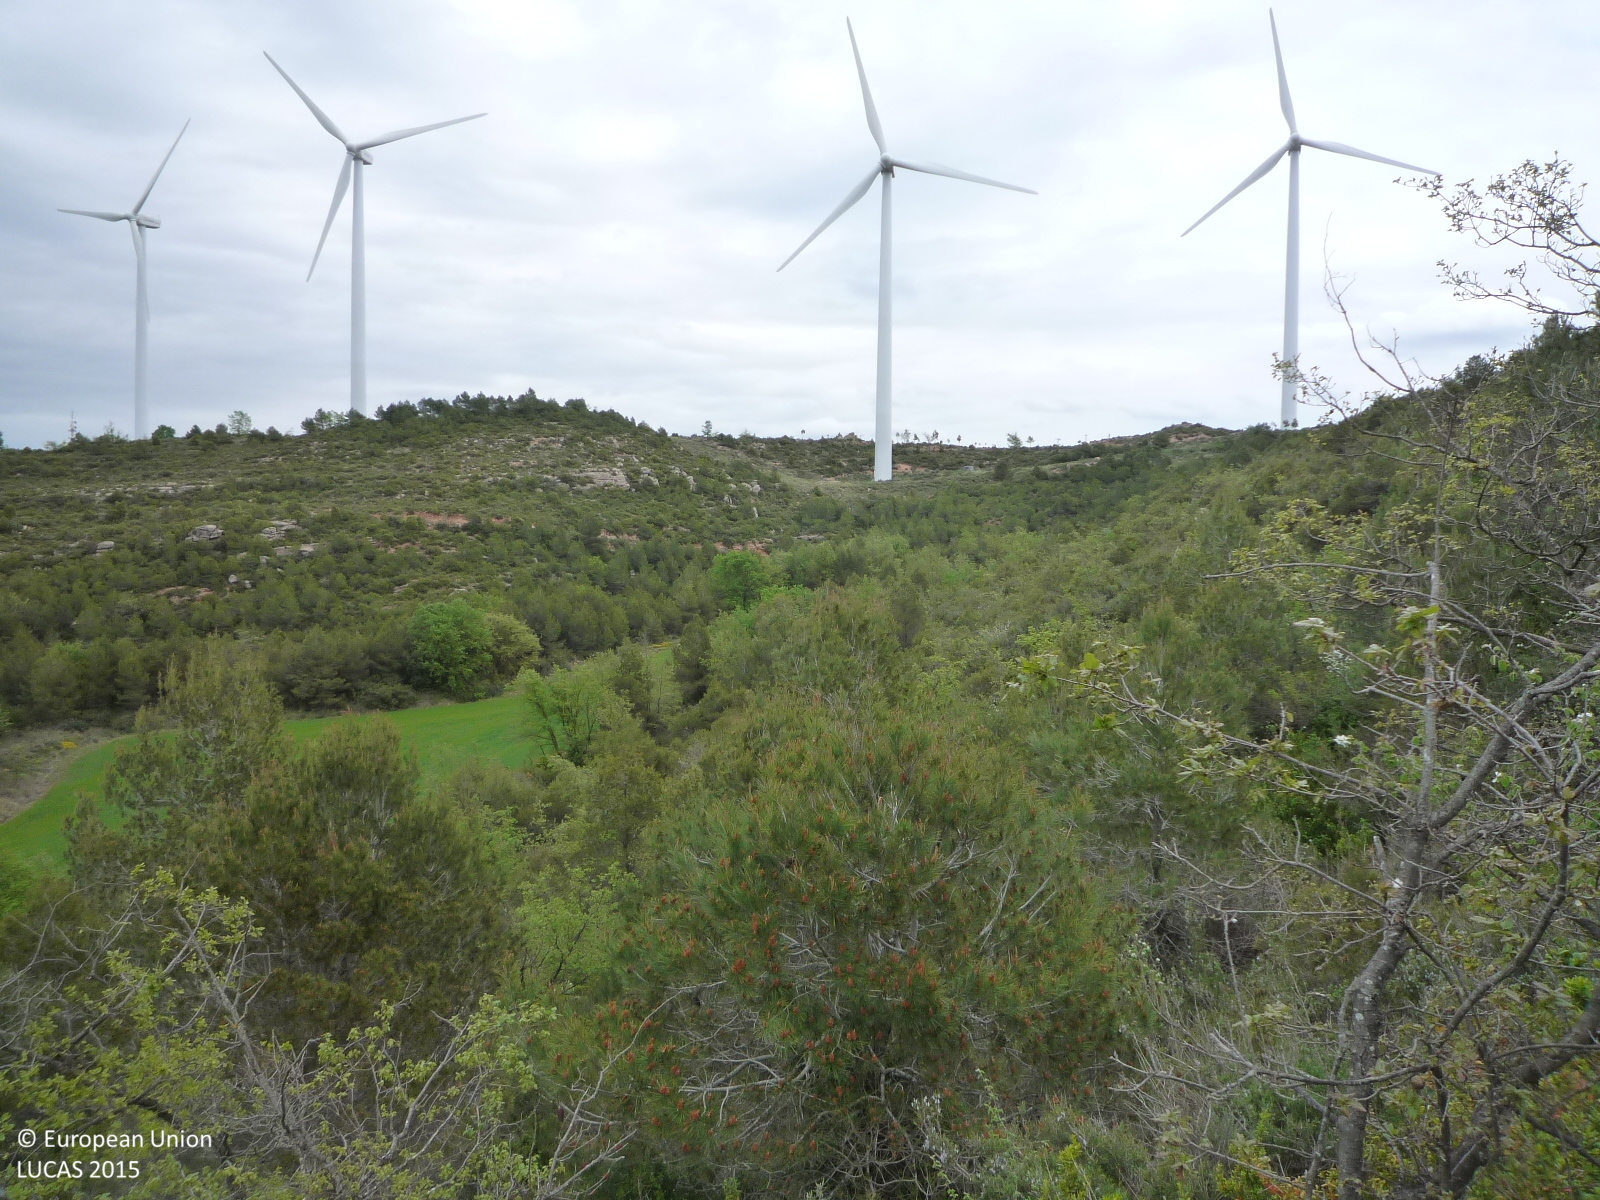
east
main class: Woodland
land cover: Pine dominated mixed woodland
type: coniferous forest of the mediterranean region
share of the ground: 50 - 75 %
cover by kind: coniferous forest trees 65 %, broadleaved forest trees 35 %
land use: Semi-natural and natural areas not in use
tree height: < 5 m
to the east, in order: Pine dominated mixed woodland; Rock outcrops; Pine dominated mixed woodland; Dry stone walls; Tracks; Pine dominated mixed woodland; Barley; Pine dominated coniferous woodland; Tracks; Pine dominated coniferous woodland; Rock outcrops; Pine dominated coniferous woodland
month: April
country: ES
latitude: 41.6509
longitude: 1.5979
